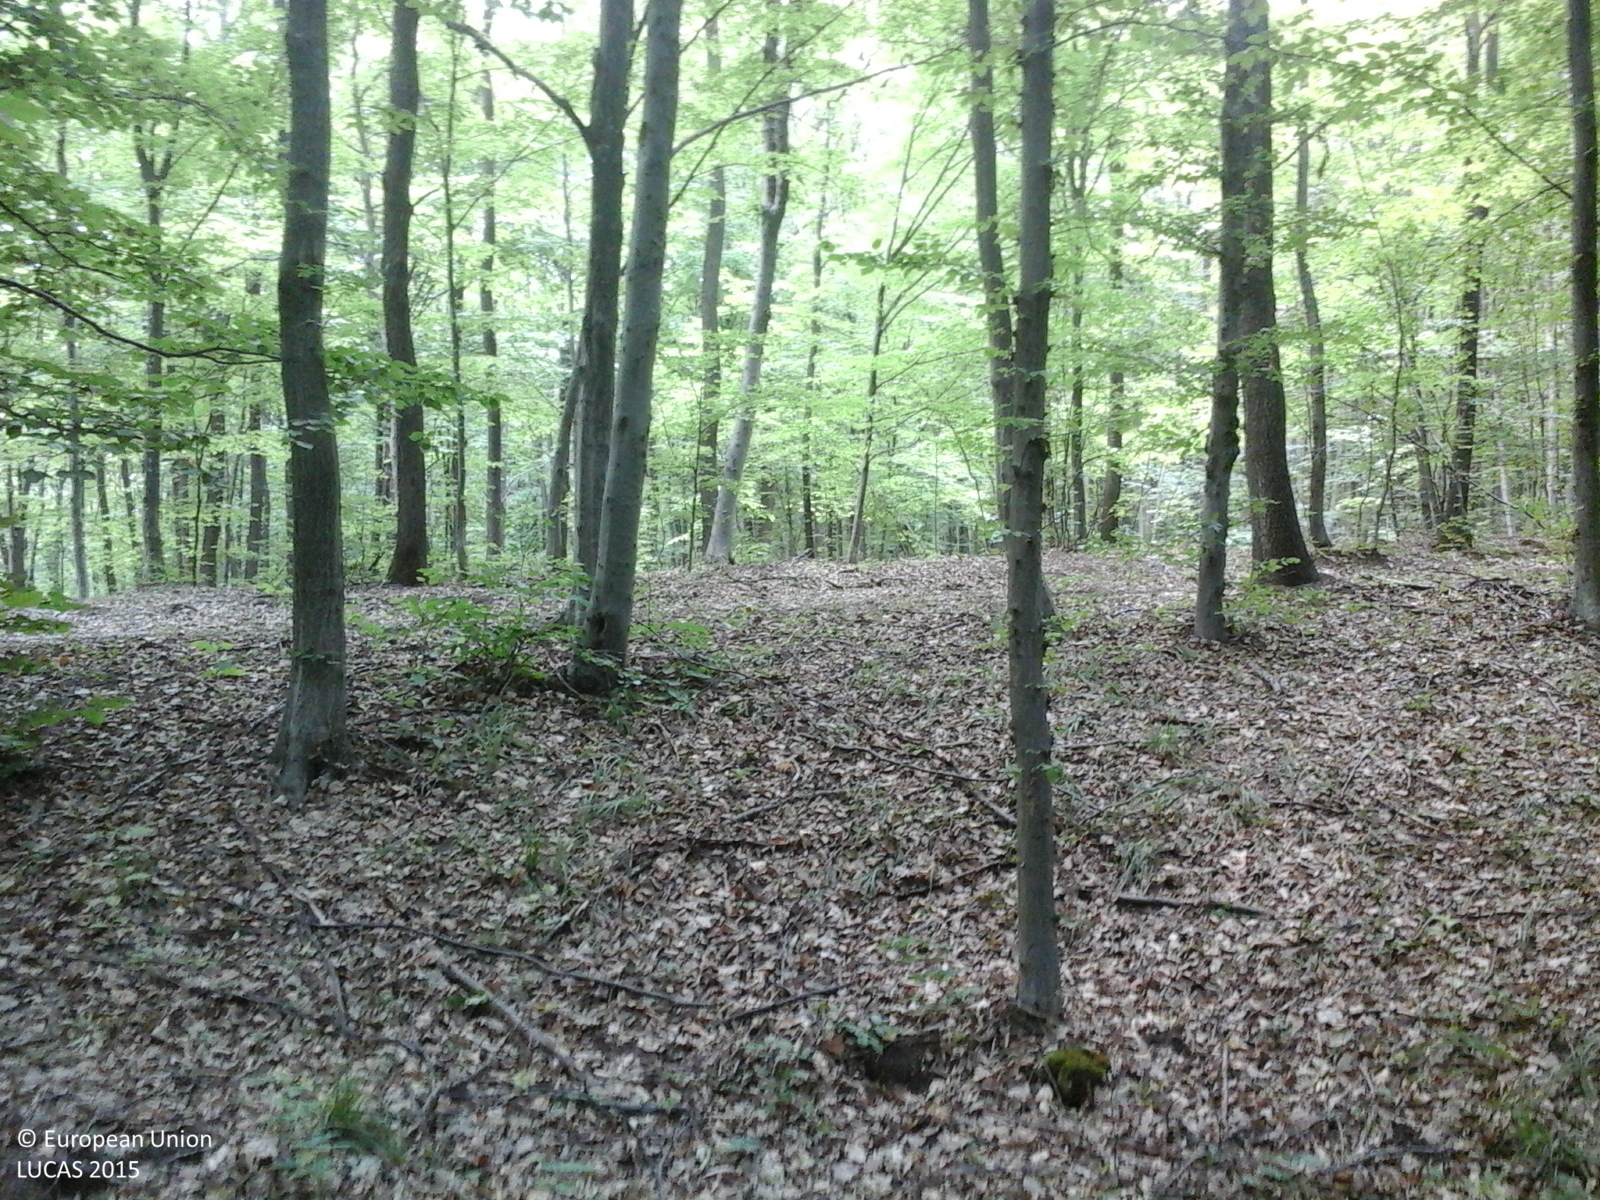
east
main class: Woodland
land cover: Broadleaved woodland
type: beech forest
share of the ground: > 75 %
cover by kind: broadleaved forest trees 95 %, herbaceous plants 5 %
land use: Forestry
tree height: > 5 m
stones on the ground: < 10 %
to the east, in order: Broadleaved woodland; Tracks; Broadleaved woodland
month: June
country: RO
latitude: 47.8543
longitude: 26.3524
